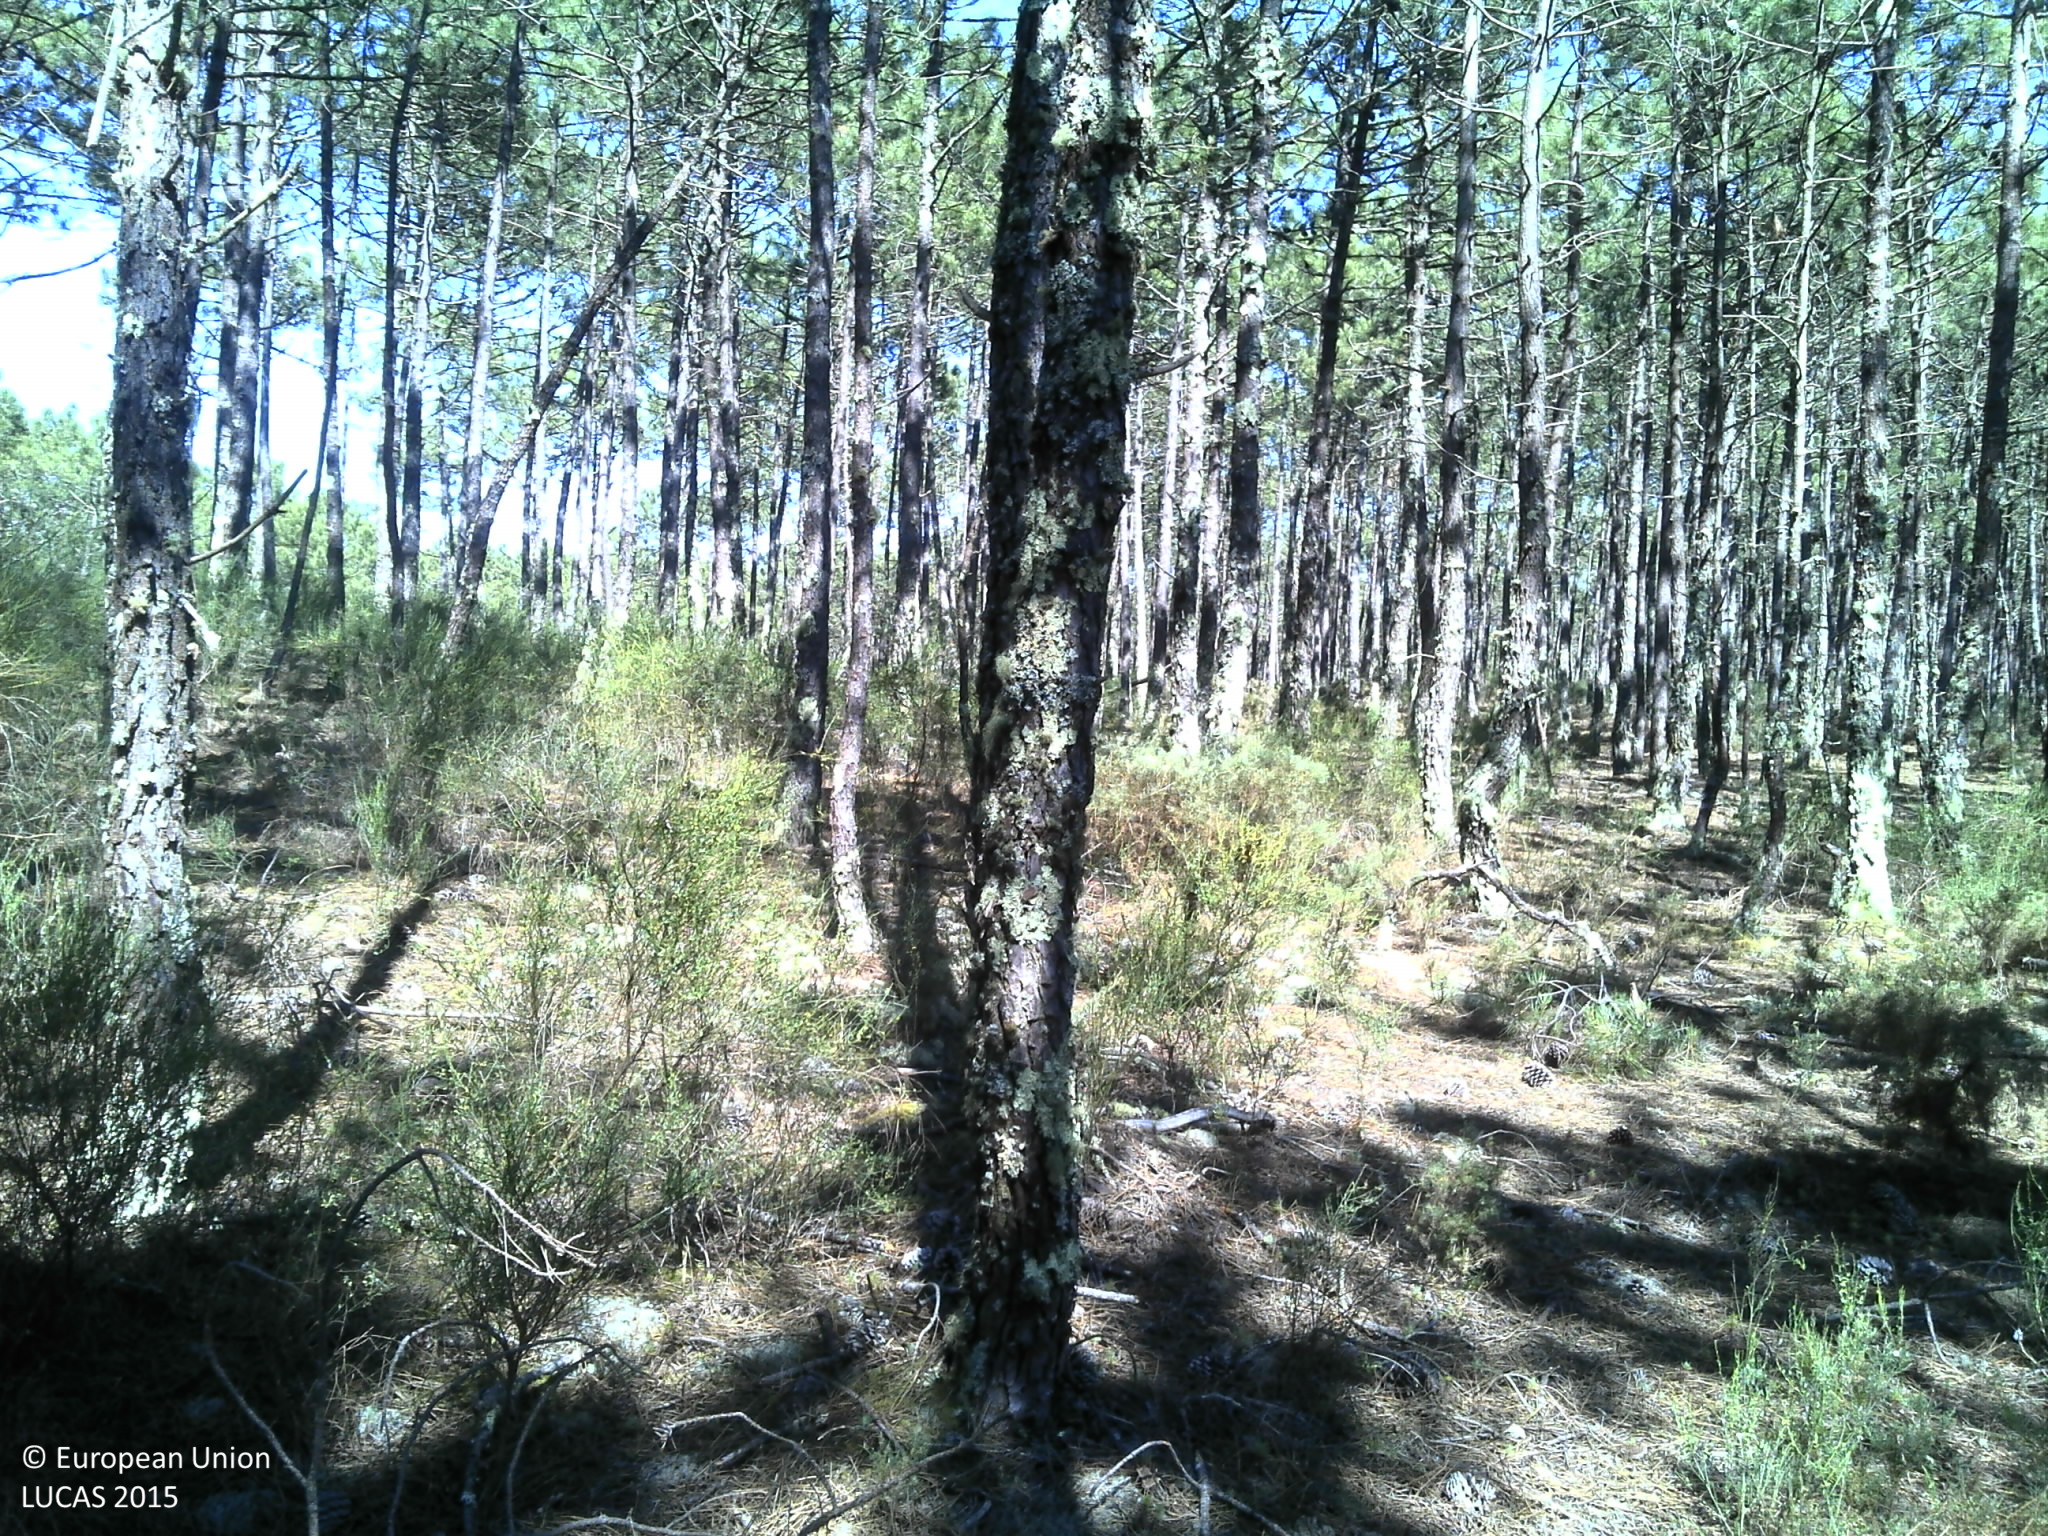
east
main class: Woodland
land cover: Pine dominated coniferous woodland
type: coniferous forest of the mediterranean region
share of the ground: 50 - 75 %
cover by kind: coniferous forest trees 75 %, unconsolidated bare surface 15 %, shrubs 10 %
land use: Forestry
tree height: > 5 m
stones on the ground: < 10 %
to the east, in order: Pine dominated coniferous woodland; Tracks; Pine dominated coniferous woodland
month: May
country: PT
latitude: 40.5742
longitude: -8.7274
